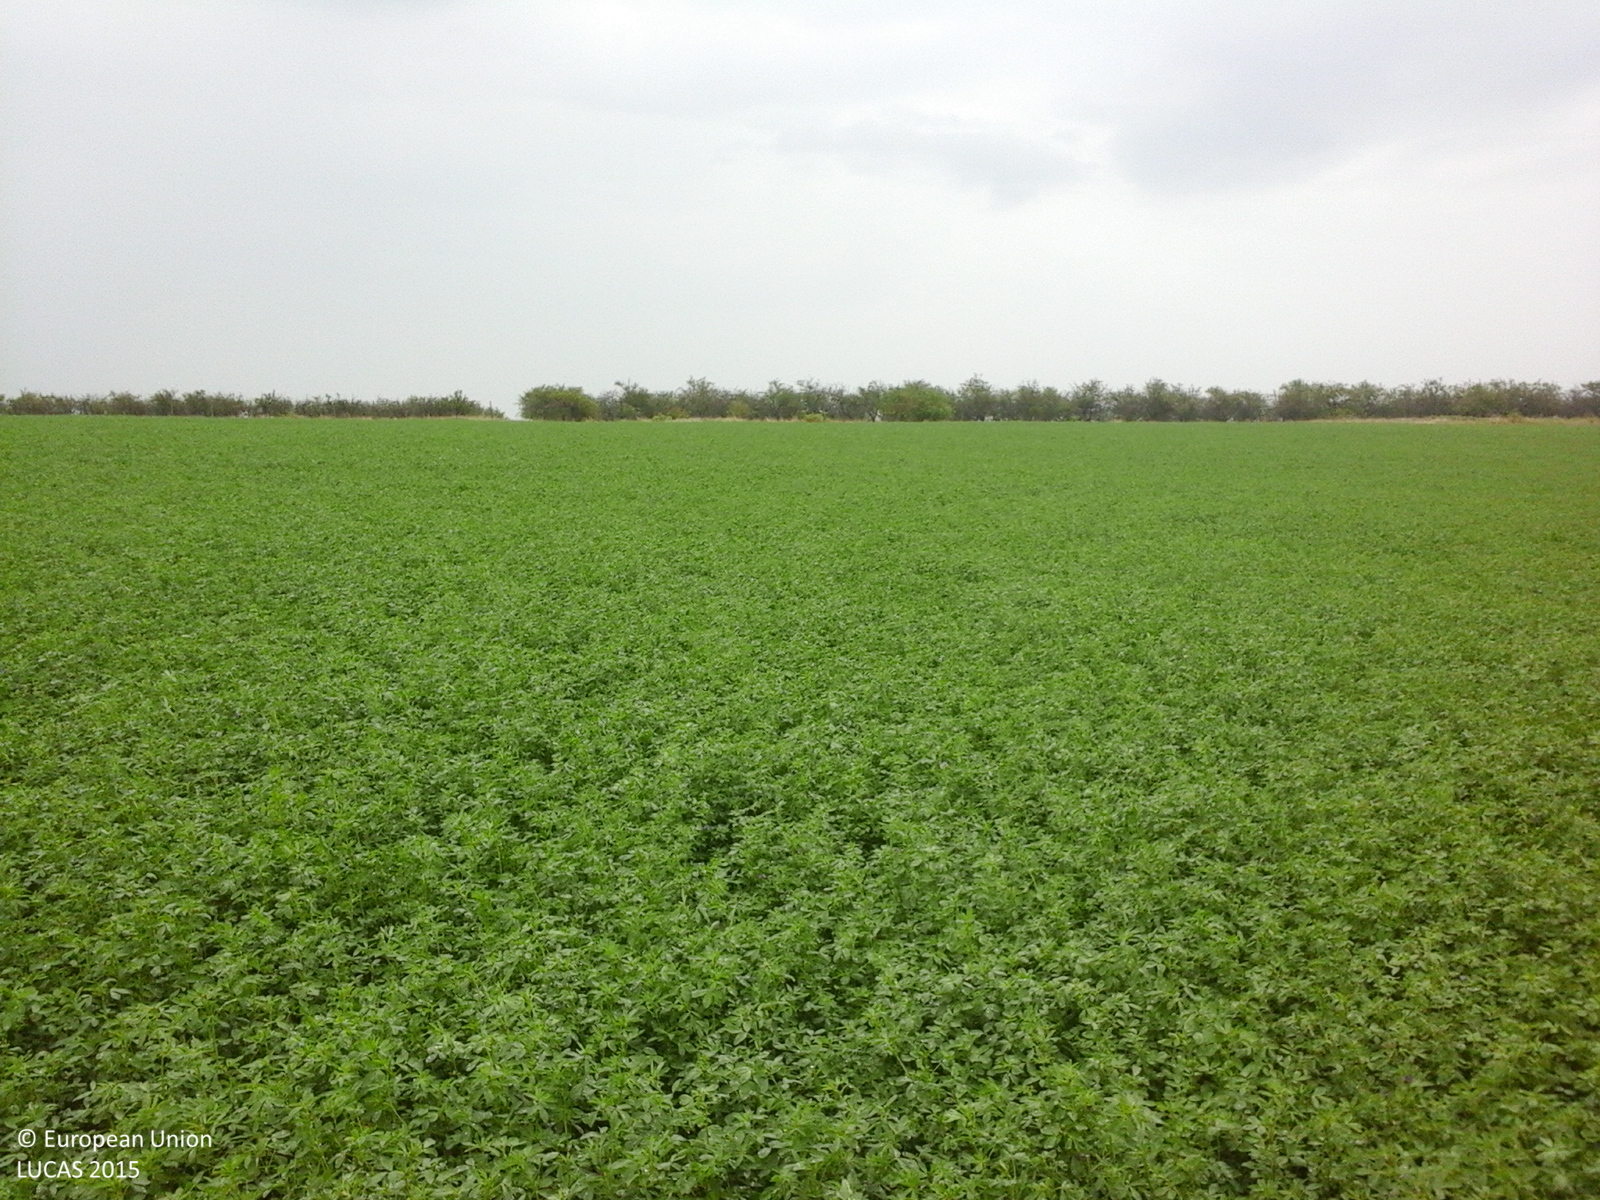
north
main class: Cropland
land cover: Lucerne
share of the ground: > 75 %
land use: Agriculture (excluding fallow land and kitchen gardens)
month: September
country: RO
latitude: 47.3409
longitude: 22.3764
